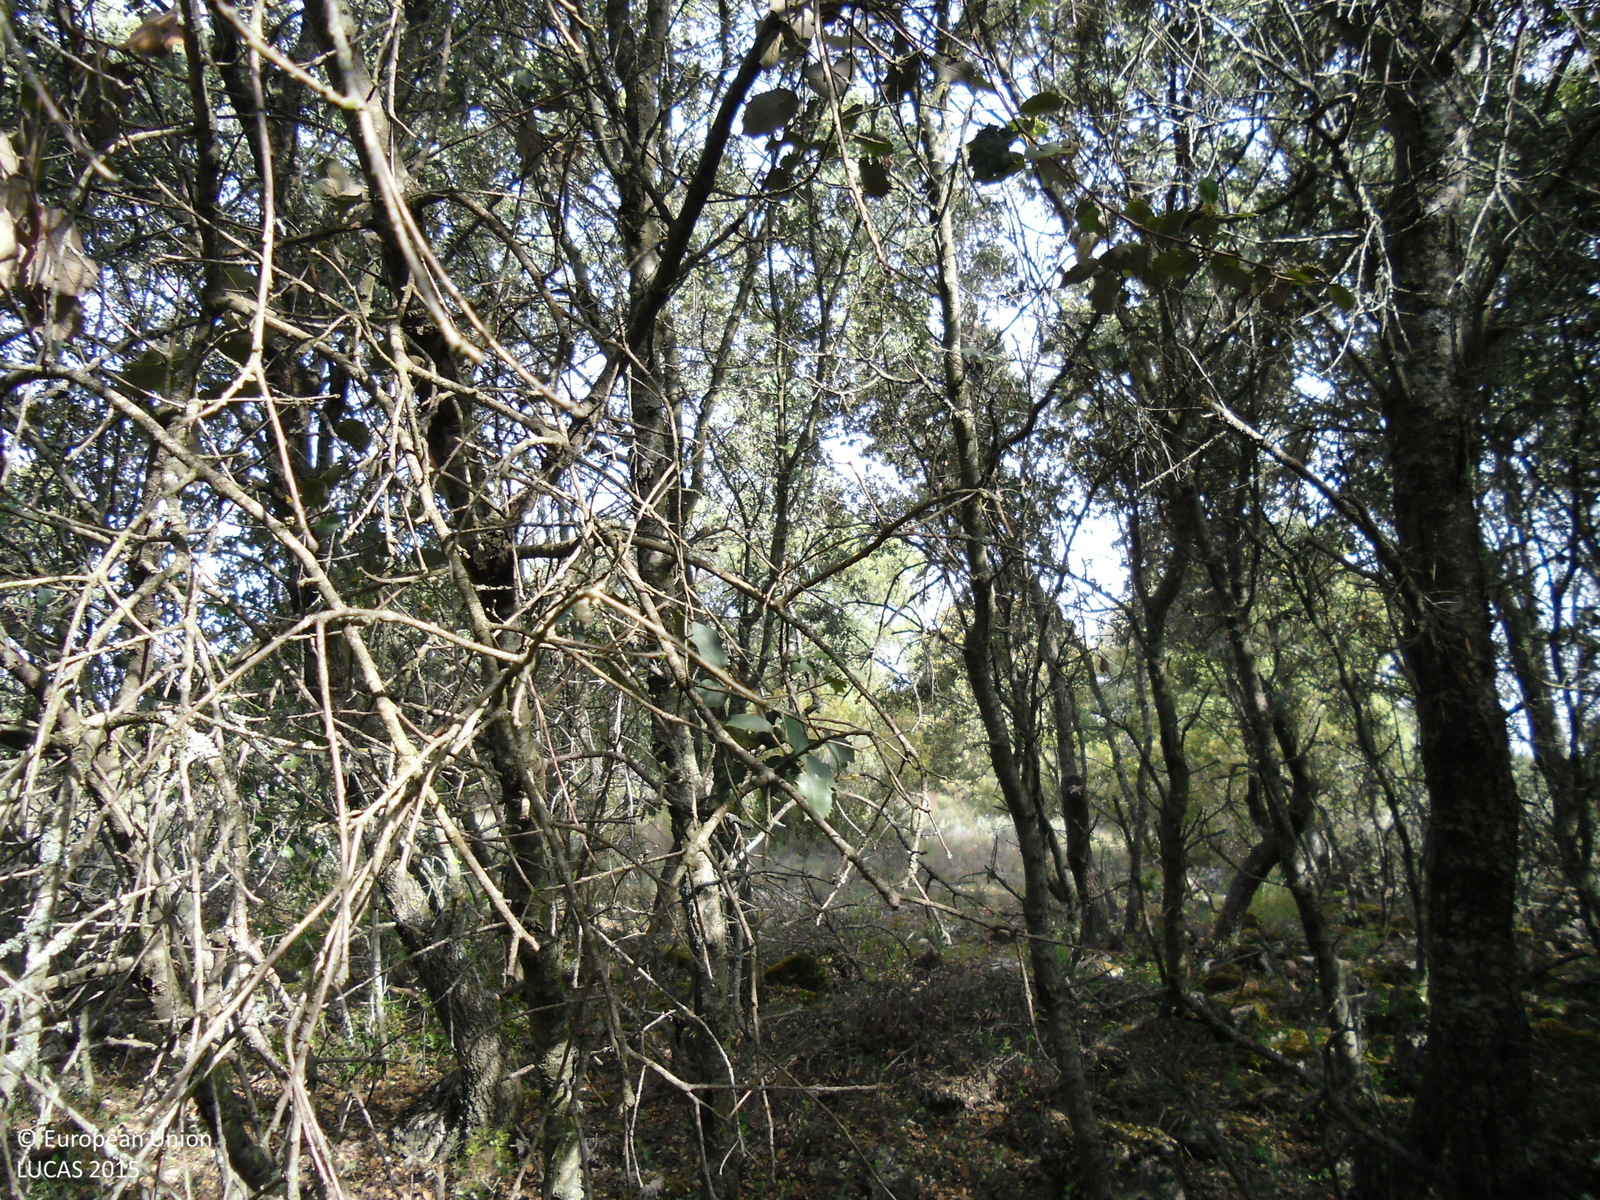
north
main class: Woodland
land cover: Broadleaved woodland
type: thermophilous deciduous forest
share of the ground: > 75 %
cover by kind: broadleaved forest trees 95 %, herbaceous plants 5 %
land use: Semi-natural and natural areas not in use
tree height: > 5 m
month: May
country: ES
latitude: 40.4733
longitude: -2.8967
